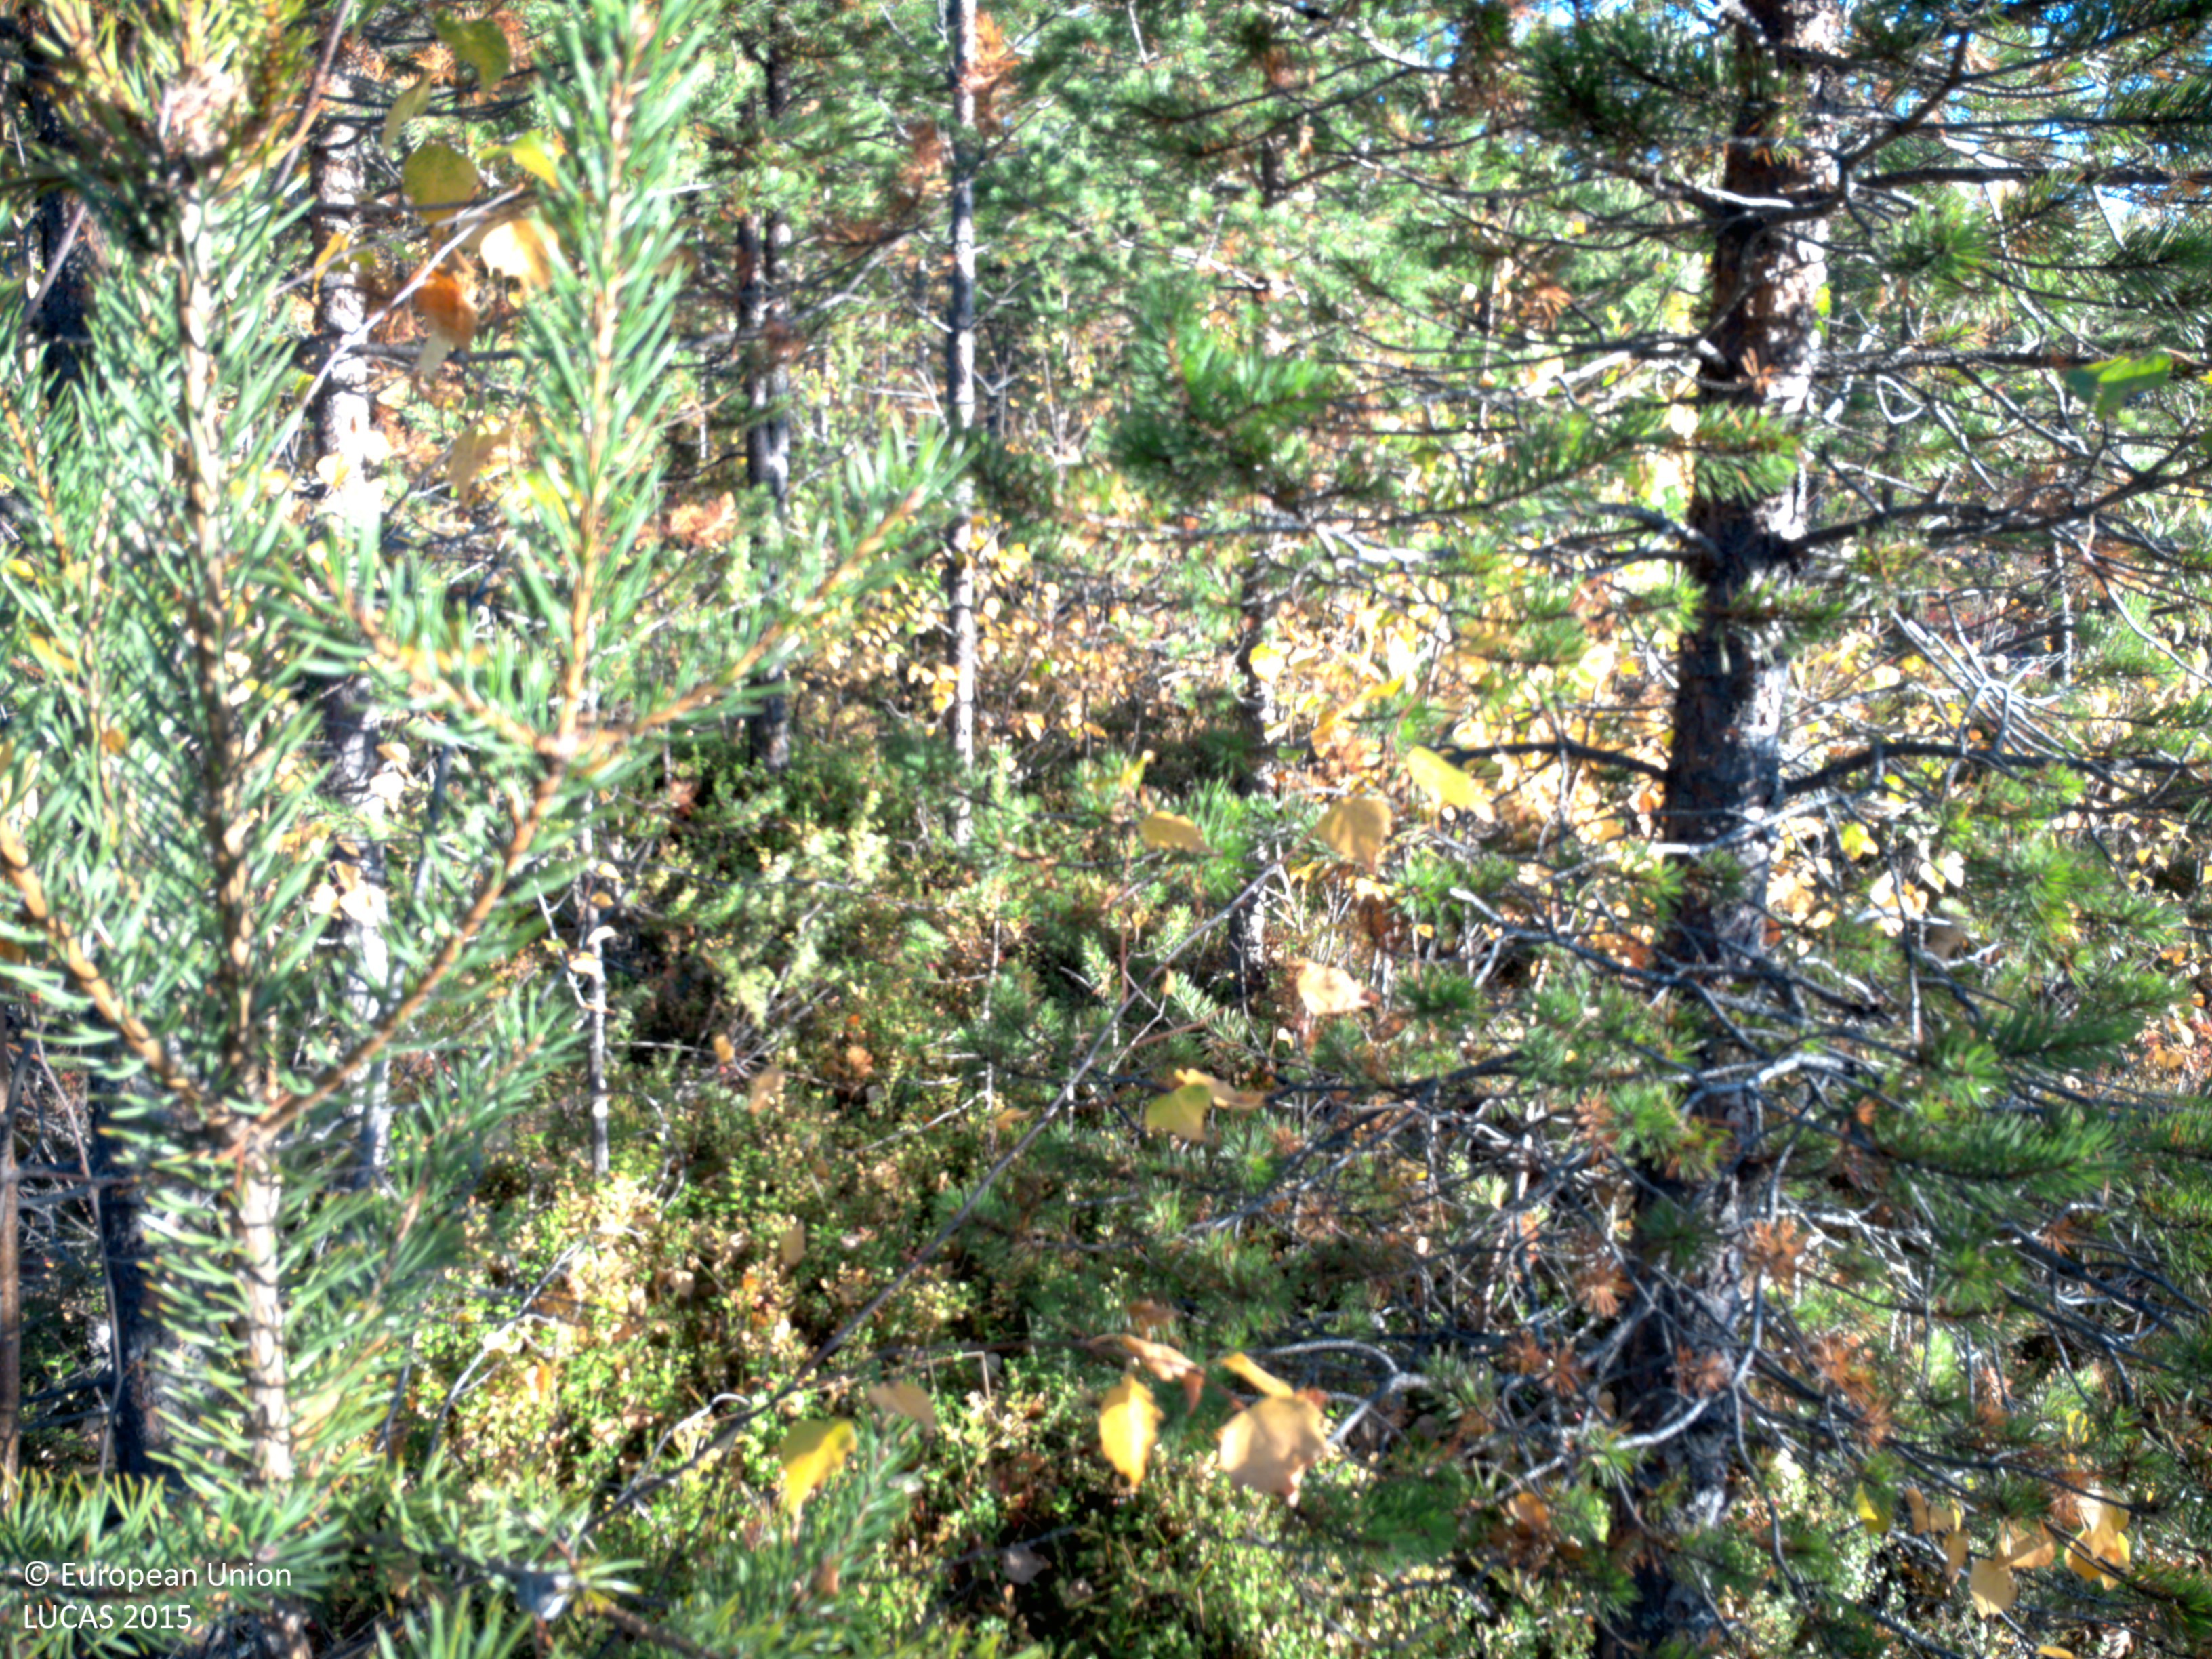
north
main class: Woodland
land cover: Pine dominated coniferous woodland
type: boreal forest
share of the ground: > 75 %
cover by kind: coniferous forest trees 75 %, broadleaved forest trees 10 %, shrubs 10 %, lichens and mosses 5 %
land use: Forestry
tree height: < 5 m
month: September
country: SE
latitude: 64.7376
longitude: 18.7664
